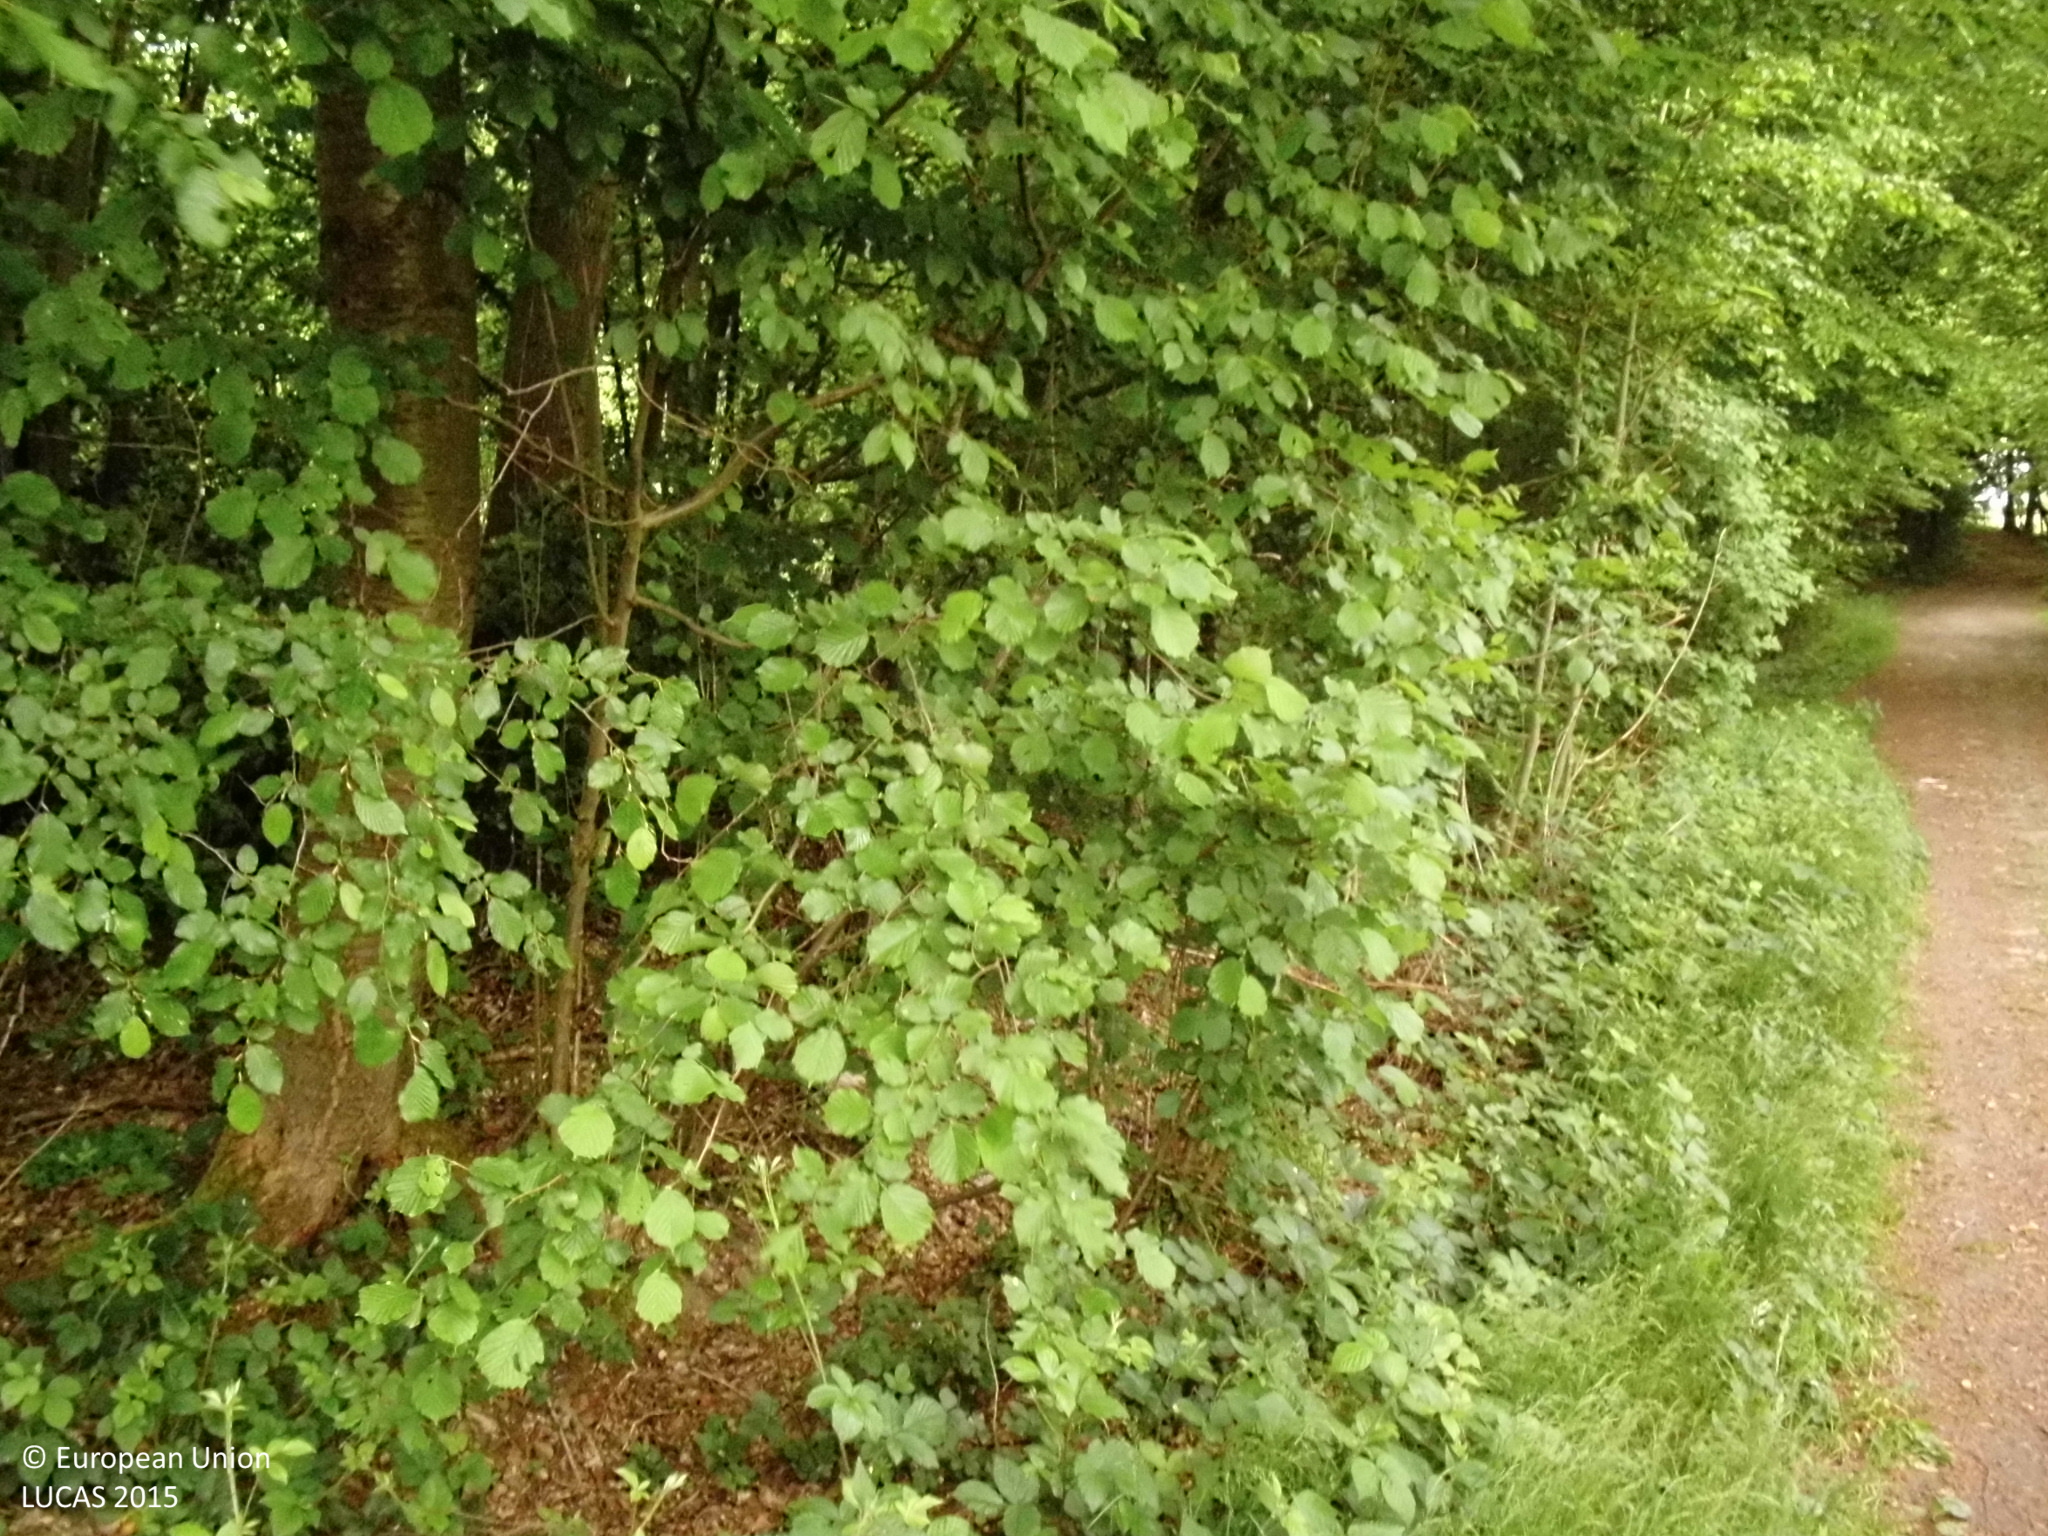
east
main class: Woodland
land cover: Broadleaved woodland
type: mesophytic deciduous forest
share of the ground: > 75 %
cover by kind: broadleaved forest trees 100 %
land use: Forestry
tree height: > 5 m
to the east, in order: Broadleaved woodland; Tracks; Broadleaved woodland; Grassland without tree/shrub cover
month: May
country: DE
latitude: 50.8761
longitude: 7.4847
